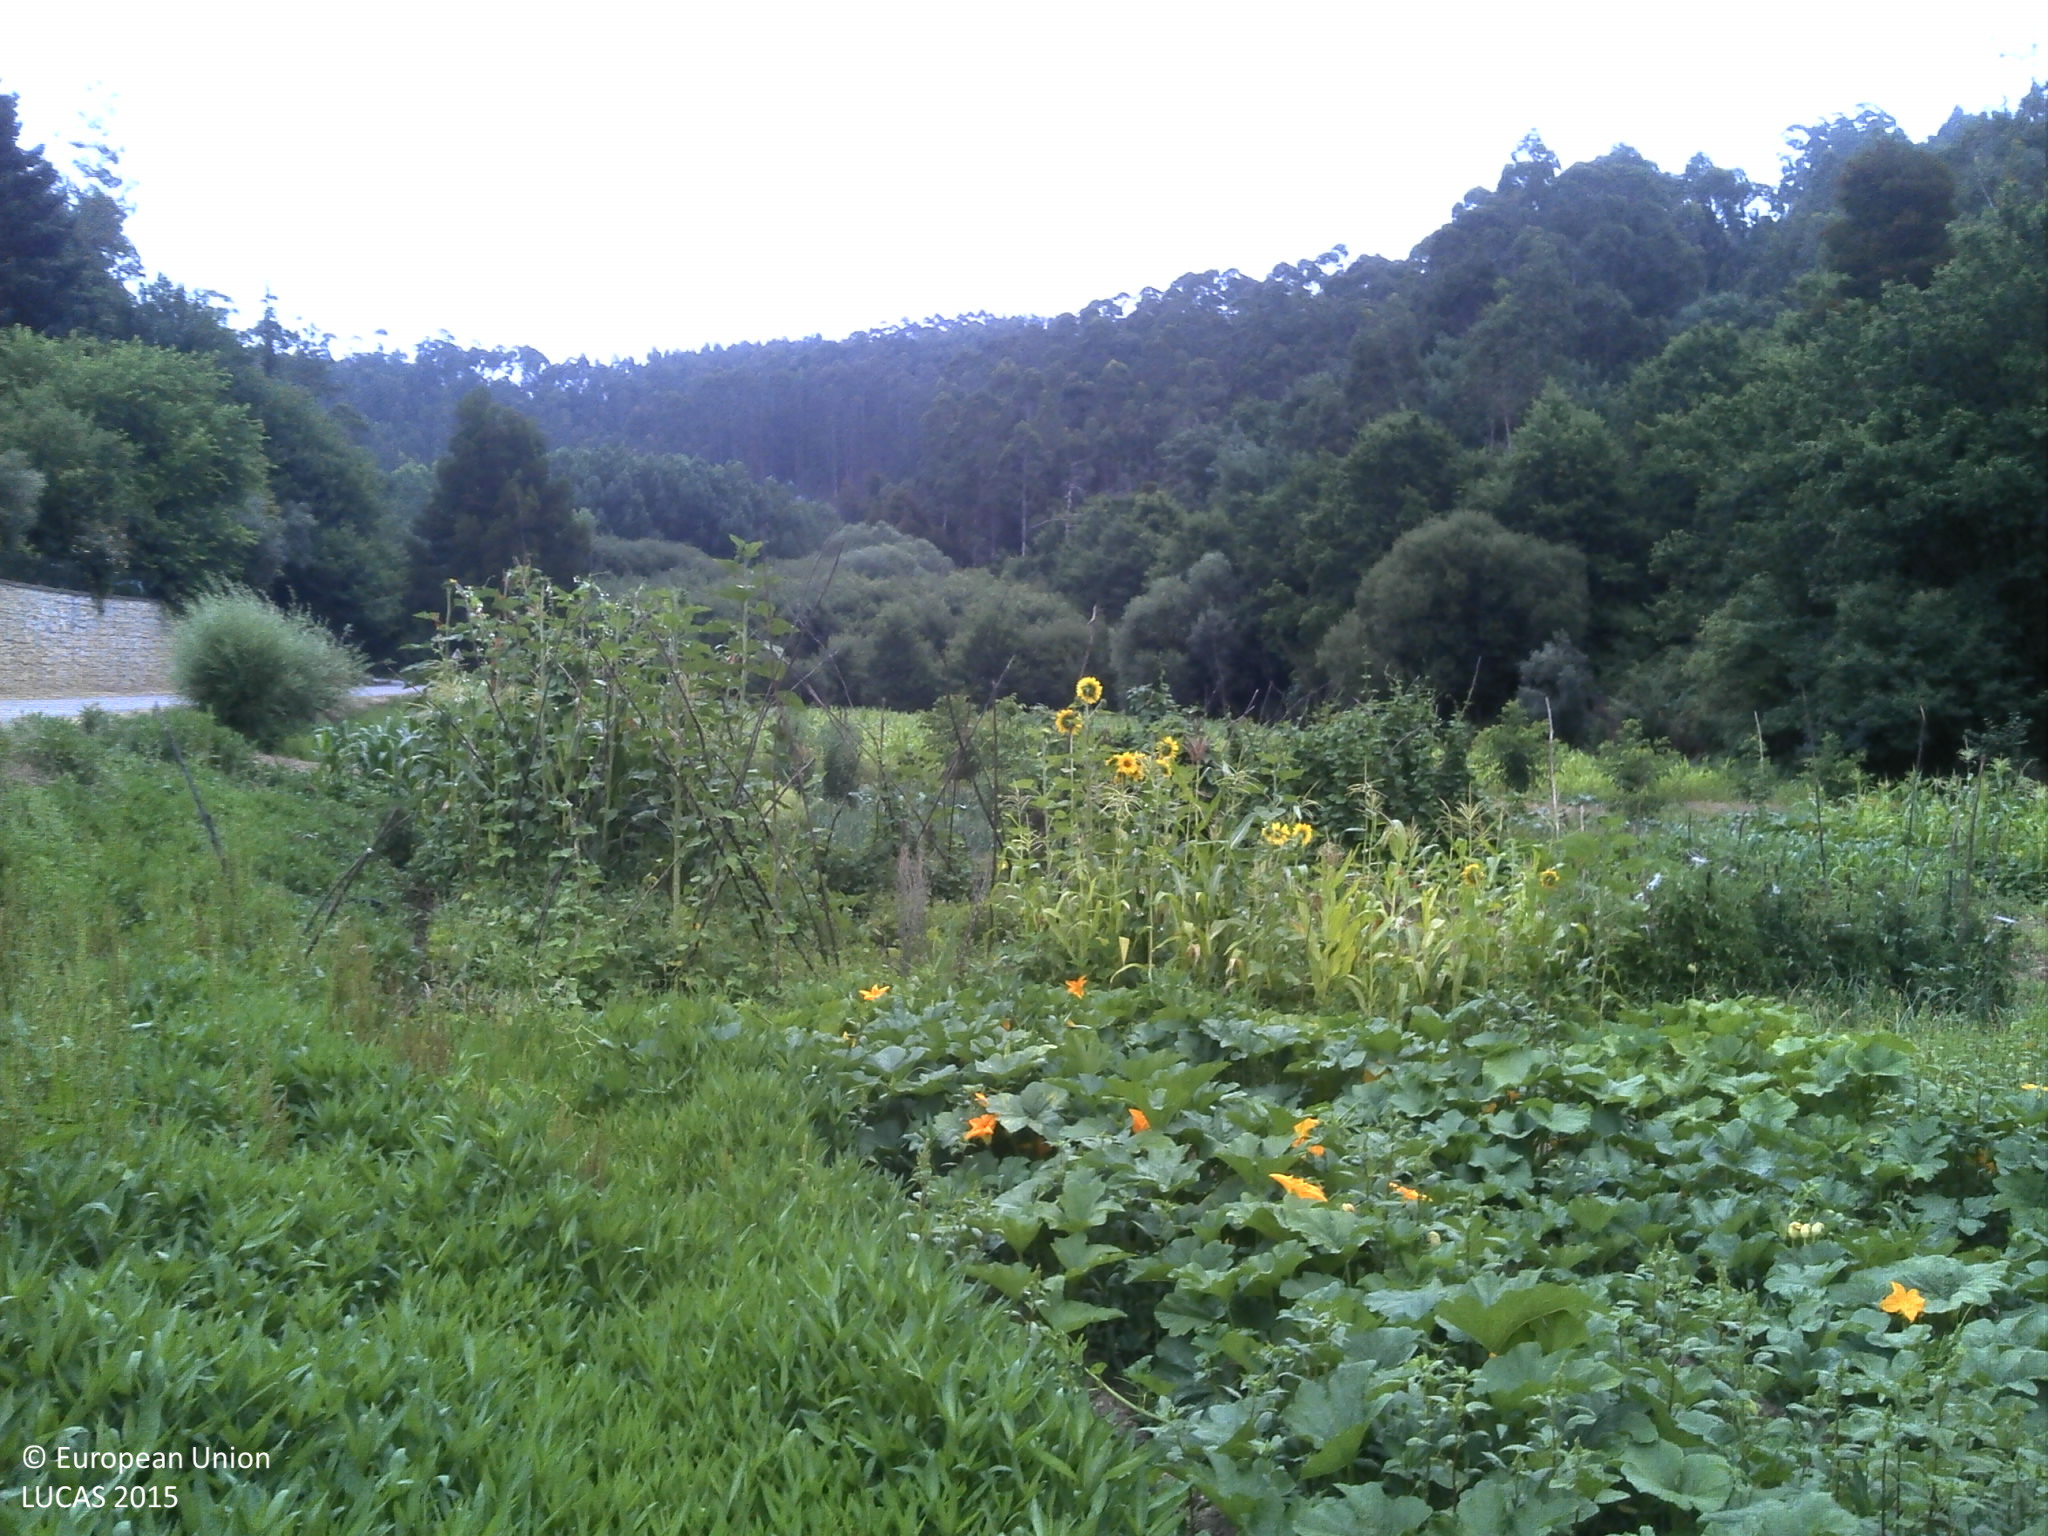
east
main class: Grassland
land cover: Grassland without tree/shrub cover
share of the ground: > 75 %
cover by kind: herbaceous plants 75 %, consolidated bare surface 15 %, unconsolidated bare surface 10 %
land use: Agriculture (excluding fallow land and kitchen gardens)
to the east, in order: Grassland without tree/shrub cover; Other fresh vegetables; Maize; Shrubland without tree cover; Broadleaved woodland; Ditches and canals; Broadleaved woodland
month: July
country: PT
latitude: 40.3820
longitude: -8.2813
